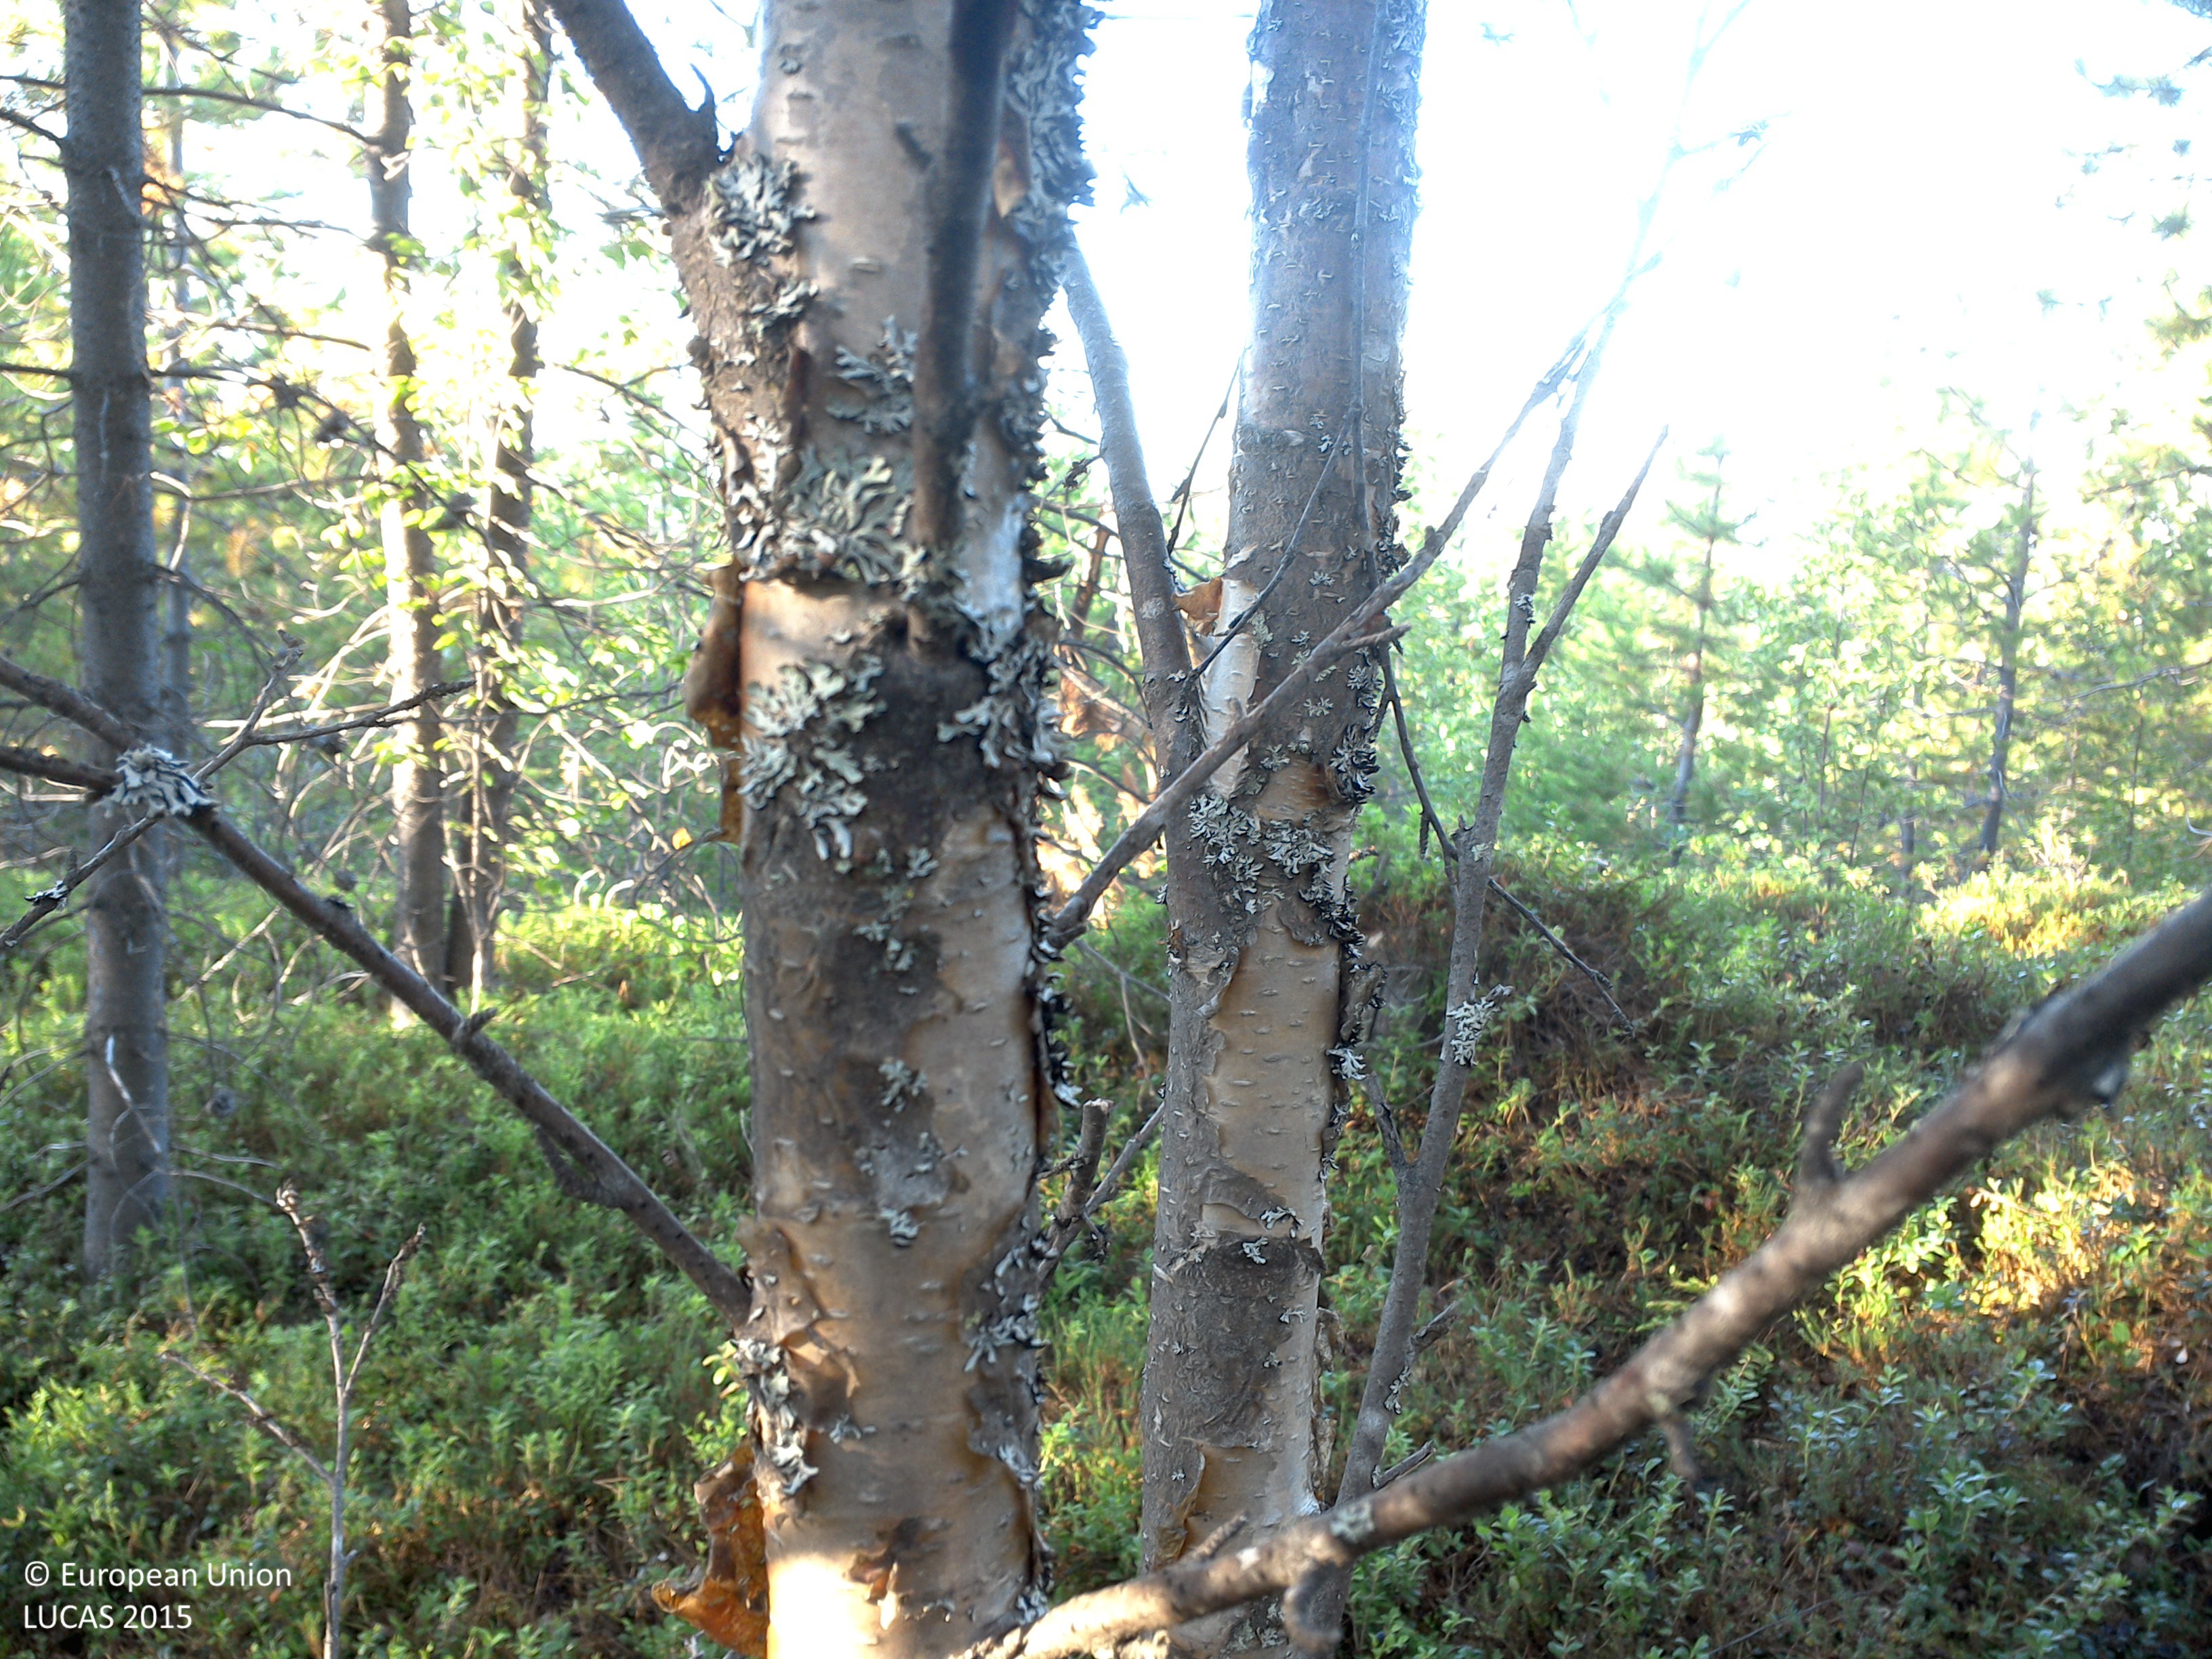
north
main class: Woodland
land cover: Pine dominated coniferous woodland
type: exotic forest
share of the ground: 50 - 75 %
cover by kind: coniferous forest trees 45 %, shrubs 45 %, broadleaved forest trees 5 %, lichens and mosses 5 %
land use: Forestry
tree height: > 5 m
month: August
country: SE
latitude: 67.0635
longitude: 21.6608
